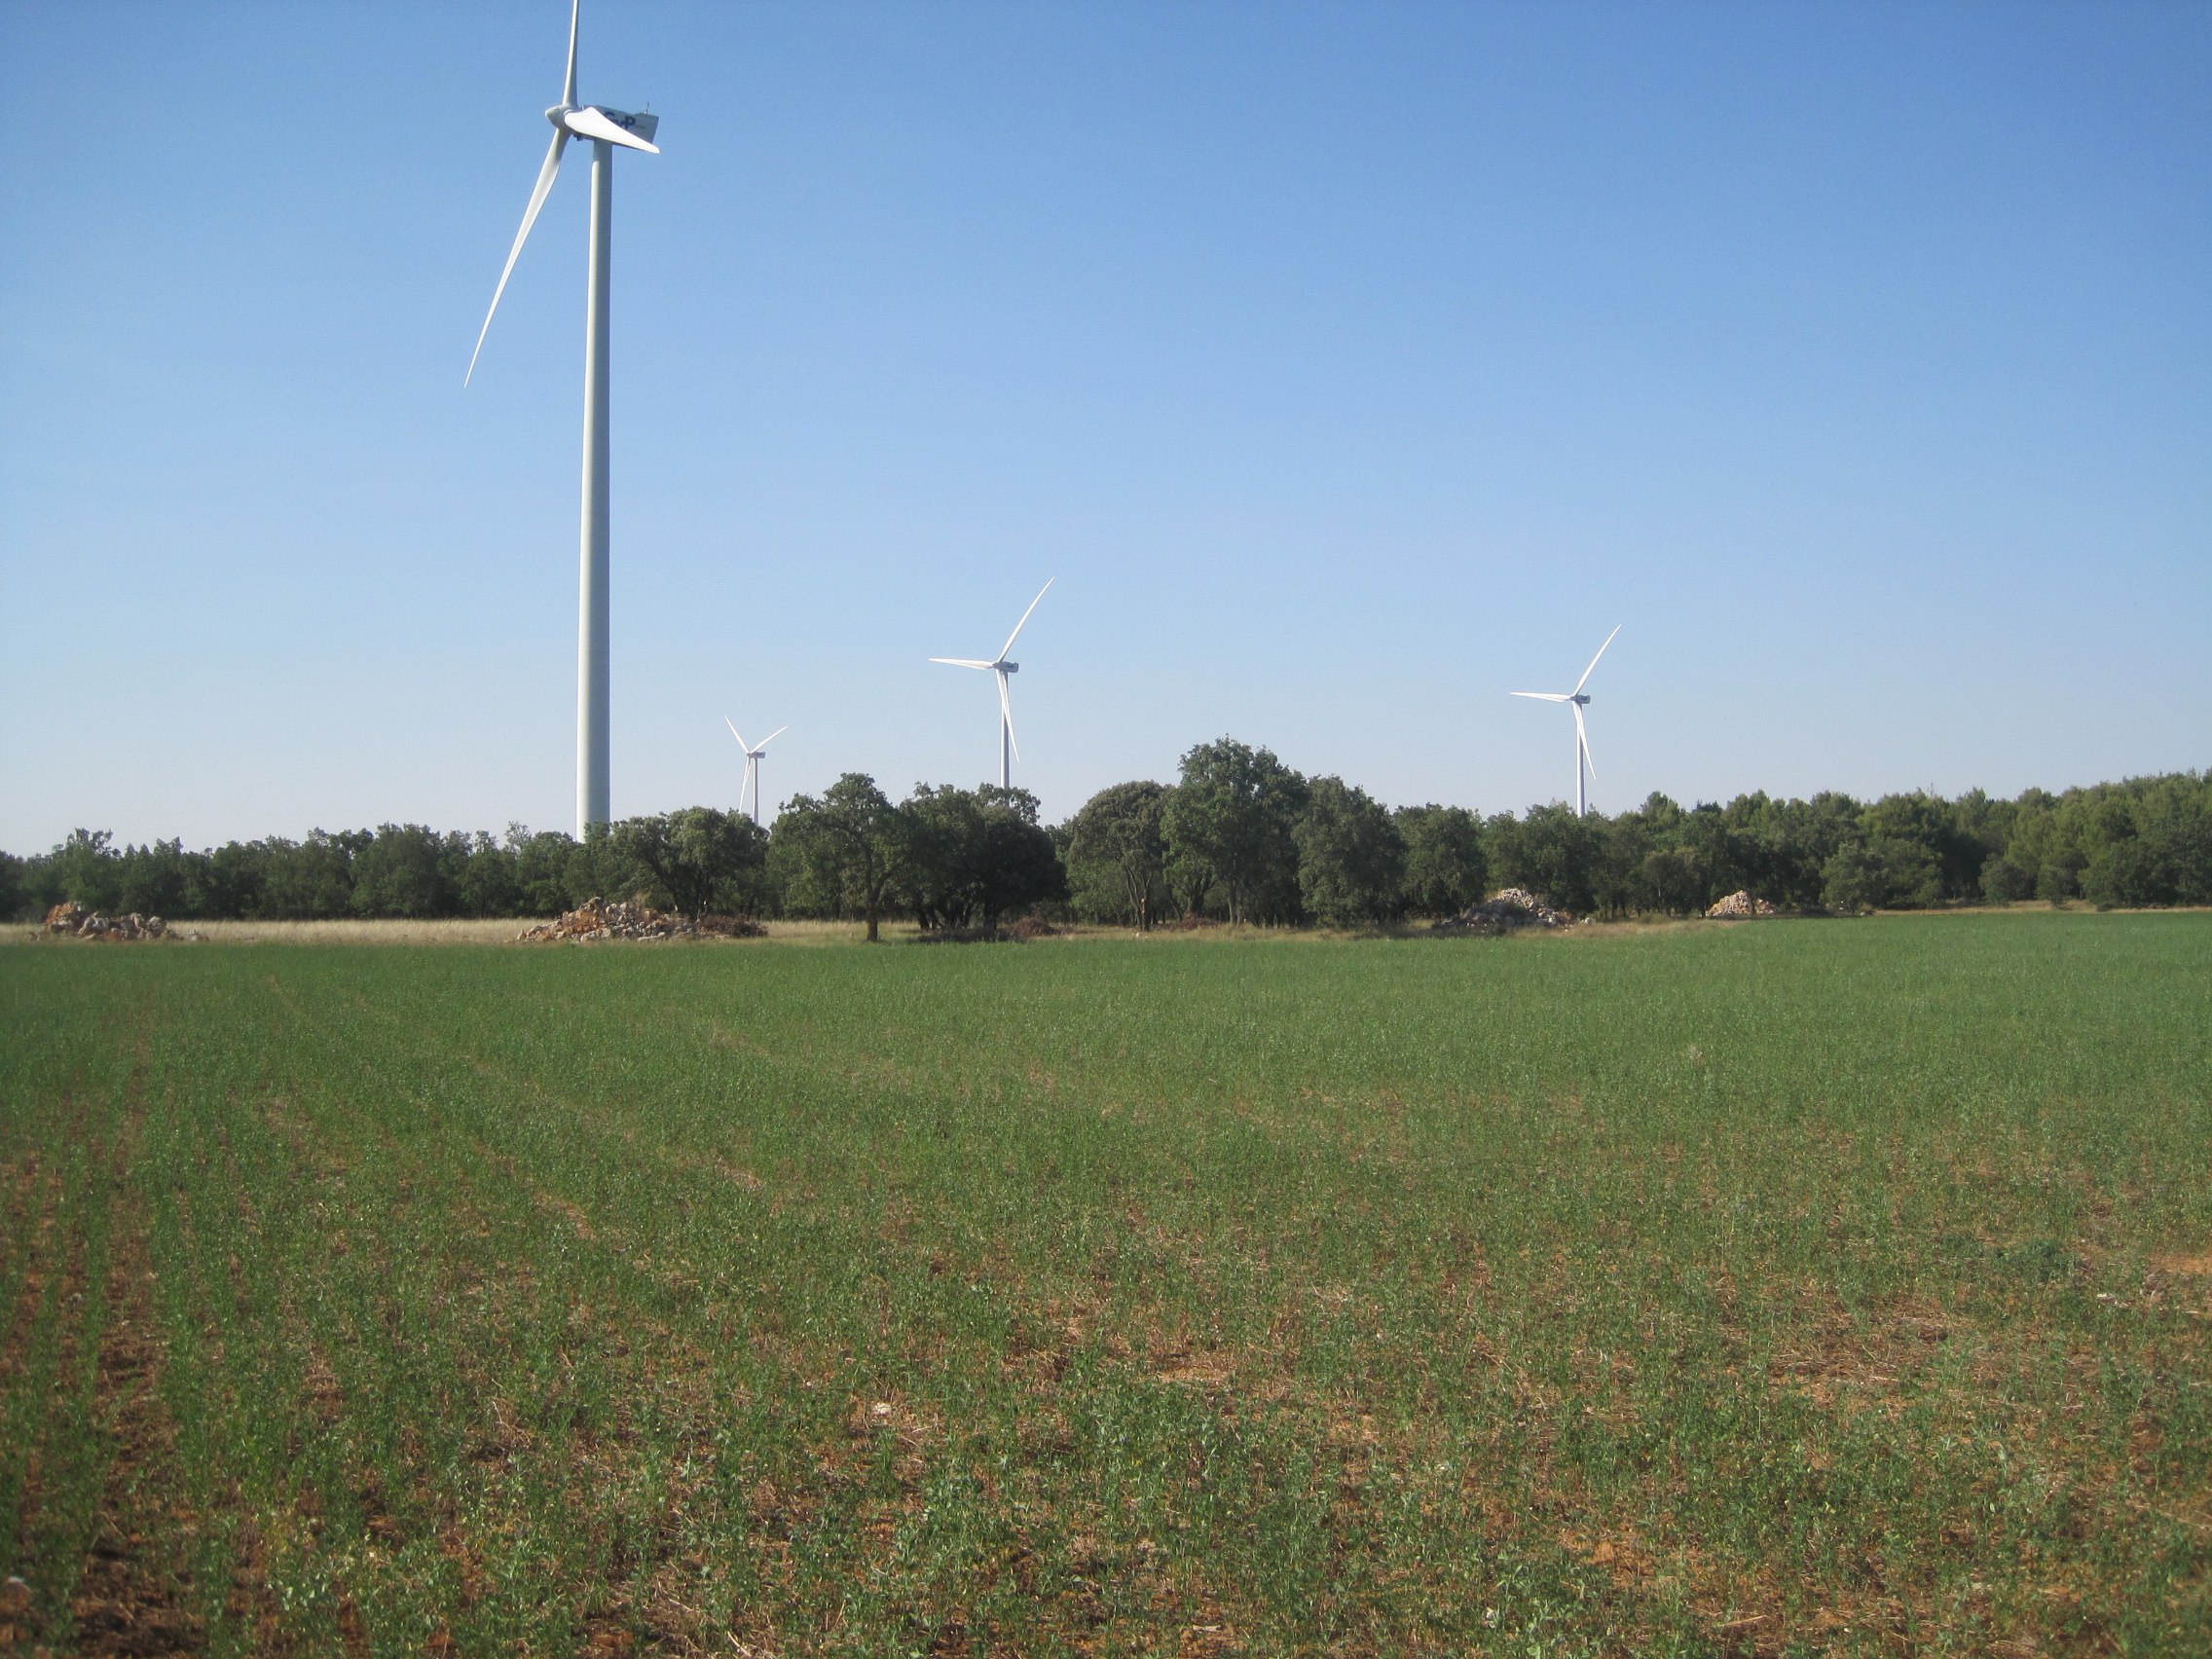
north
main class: Cropland
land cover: Lucerne
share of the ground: > 75 %
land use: Agriculture (excluding fallow land and kitchen gardens)
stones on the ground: 25 - 50 %
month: July
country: ES
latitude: 41.8773
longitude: -4.7611
